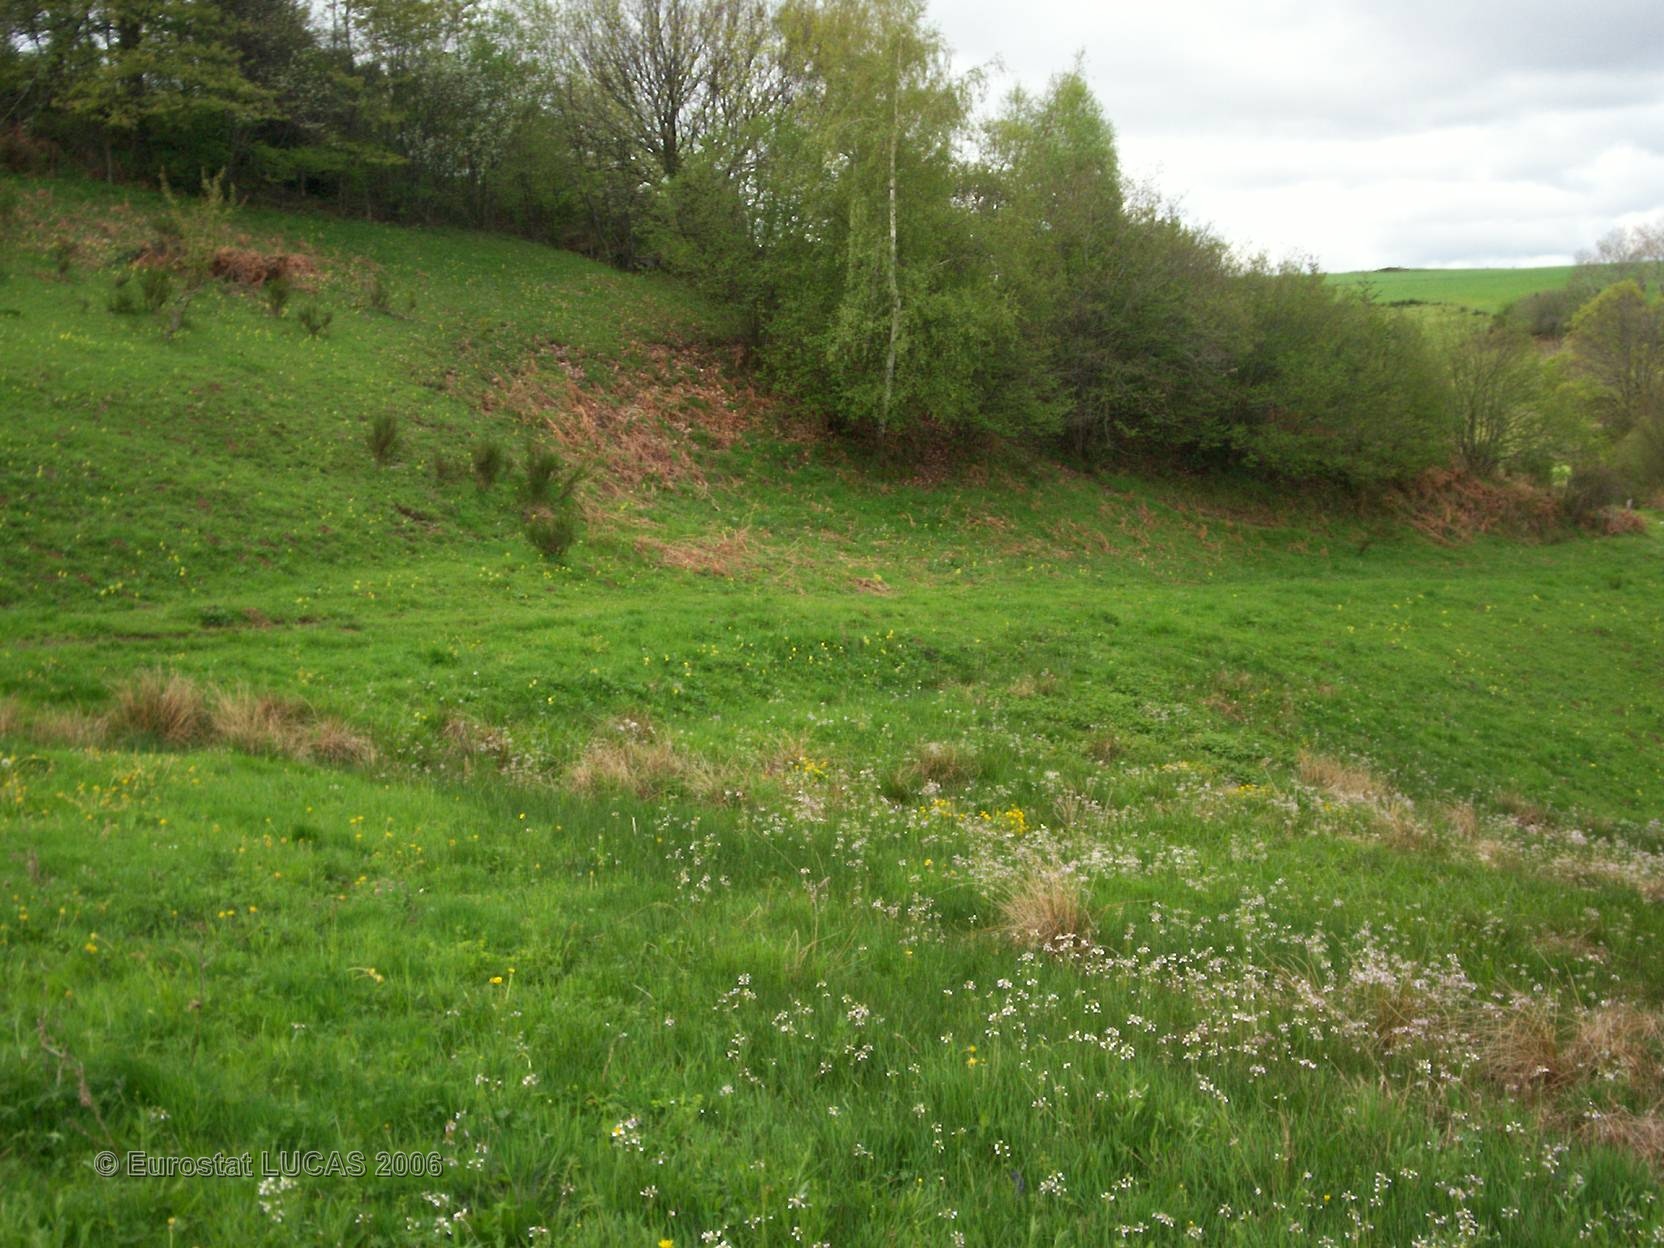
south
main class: Grassland
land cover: Grassland without tree/shrub cover
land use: Agriculture (excluding fallow land and kitchen gardens)
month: May
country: FR
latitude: 45.2154
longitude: 3.2405
